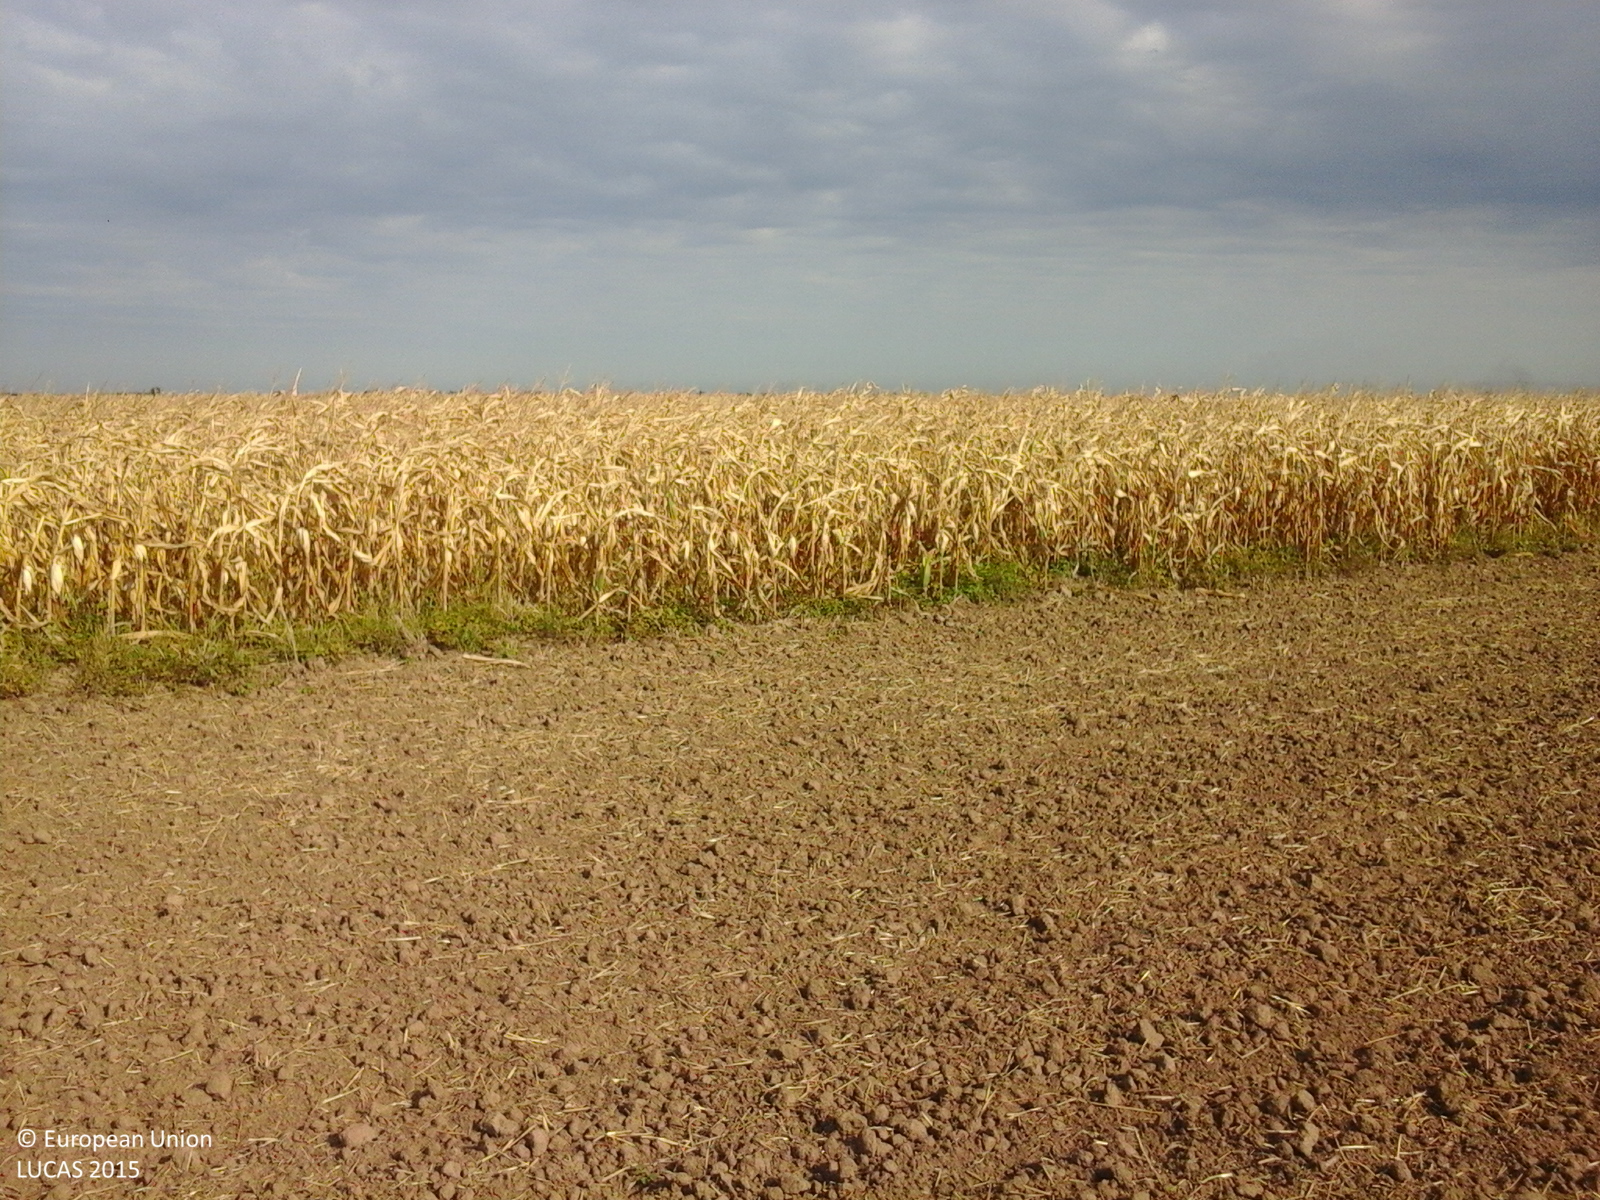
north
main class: Cropland
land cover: Common wheat
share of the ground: < 10 %
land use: Agriculture (excluding fallow land and kitchen gardens)
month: September
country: RO
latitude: 47.5584
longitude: 22.6992
